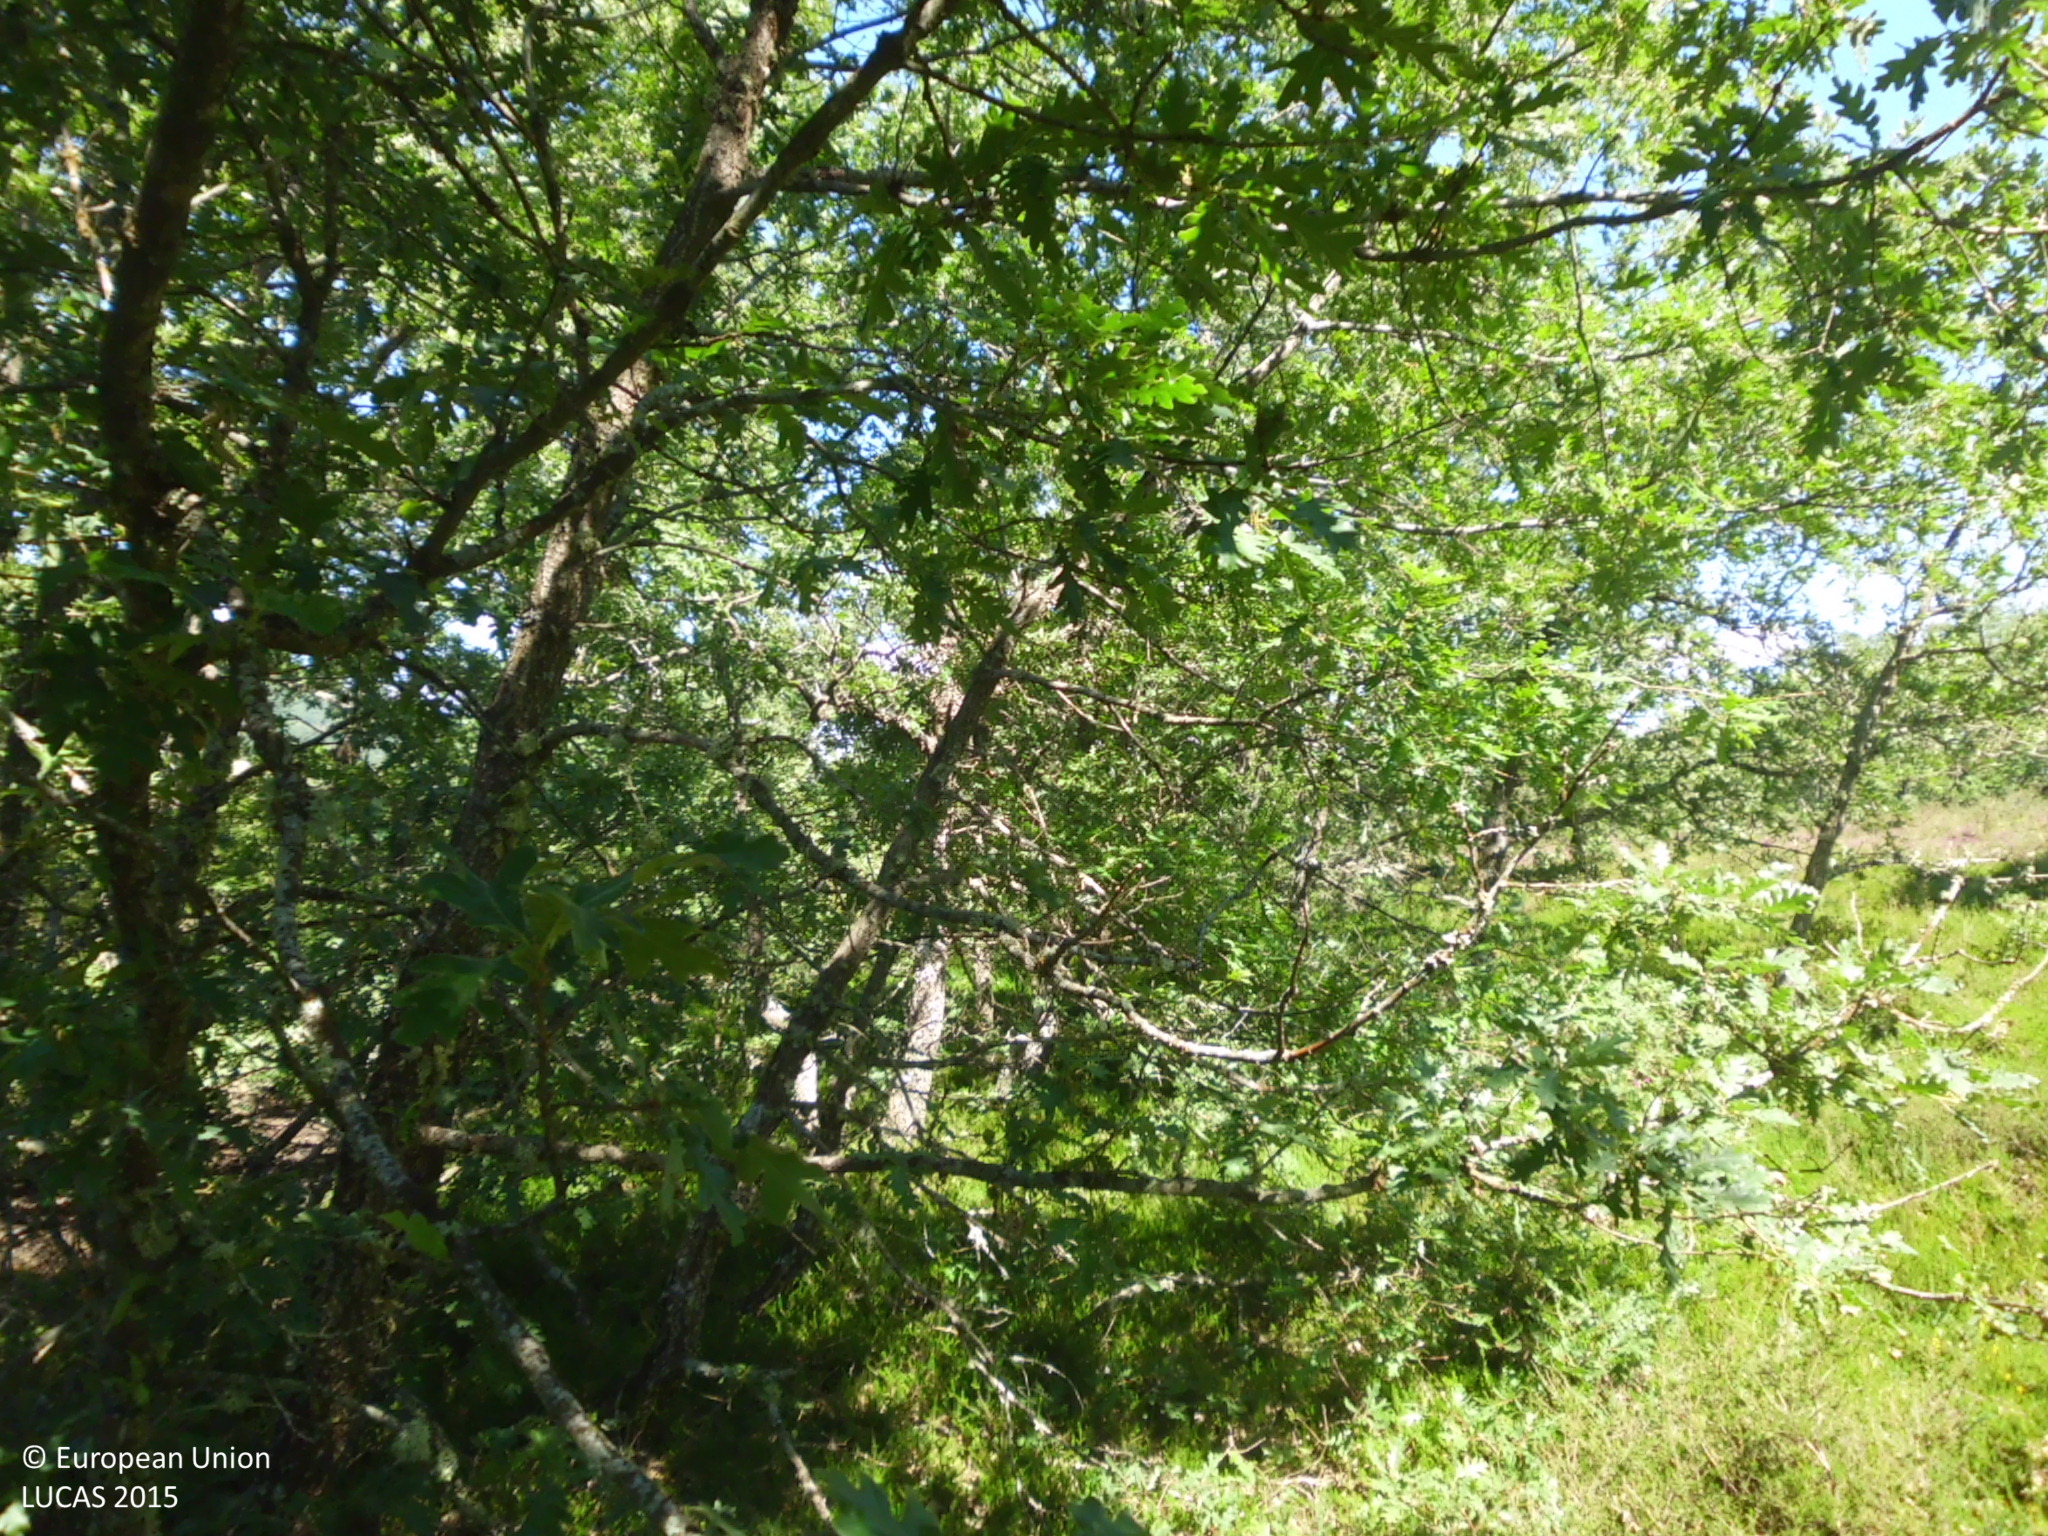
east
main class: Woodland
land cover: Broadleaved woodland
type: acidophilous oak and oak-birch forest
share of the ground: 25 - 50 %
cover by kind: broadleaved forest trees 40 %, shrubs 40 %, consolidated bare surface 15 %, herbaceous plants 5 %
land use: Semi-natural and natural areas not in use
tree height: > 5 m
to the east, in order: Broadleaved woodland; Tracks; Grass margins; Common wheat; Single bushes/trees; Common wheat; Single bushes/trees; Shrubland with sparse tree cover
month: June
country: ES
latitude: 42.6237
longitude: -4.0293
